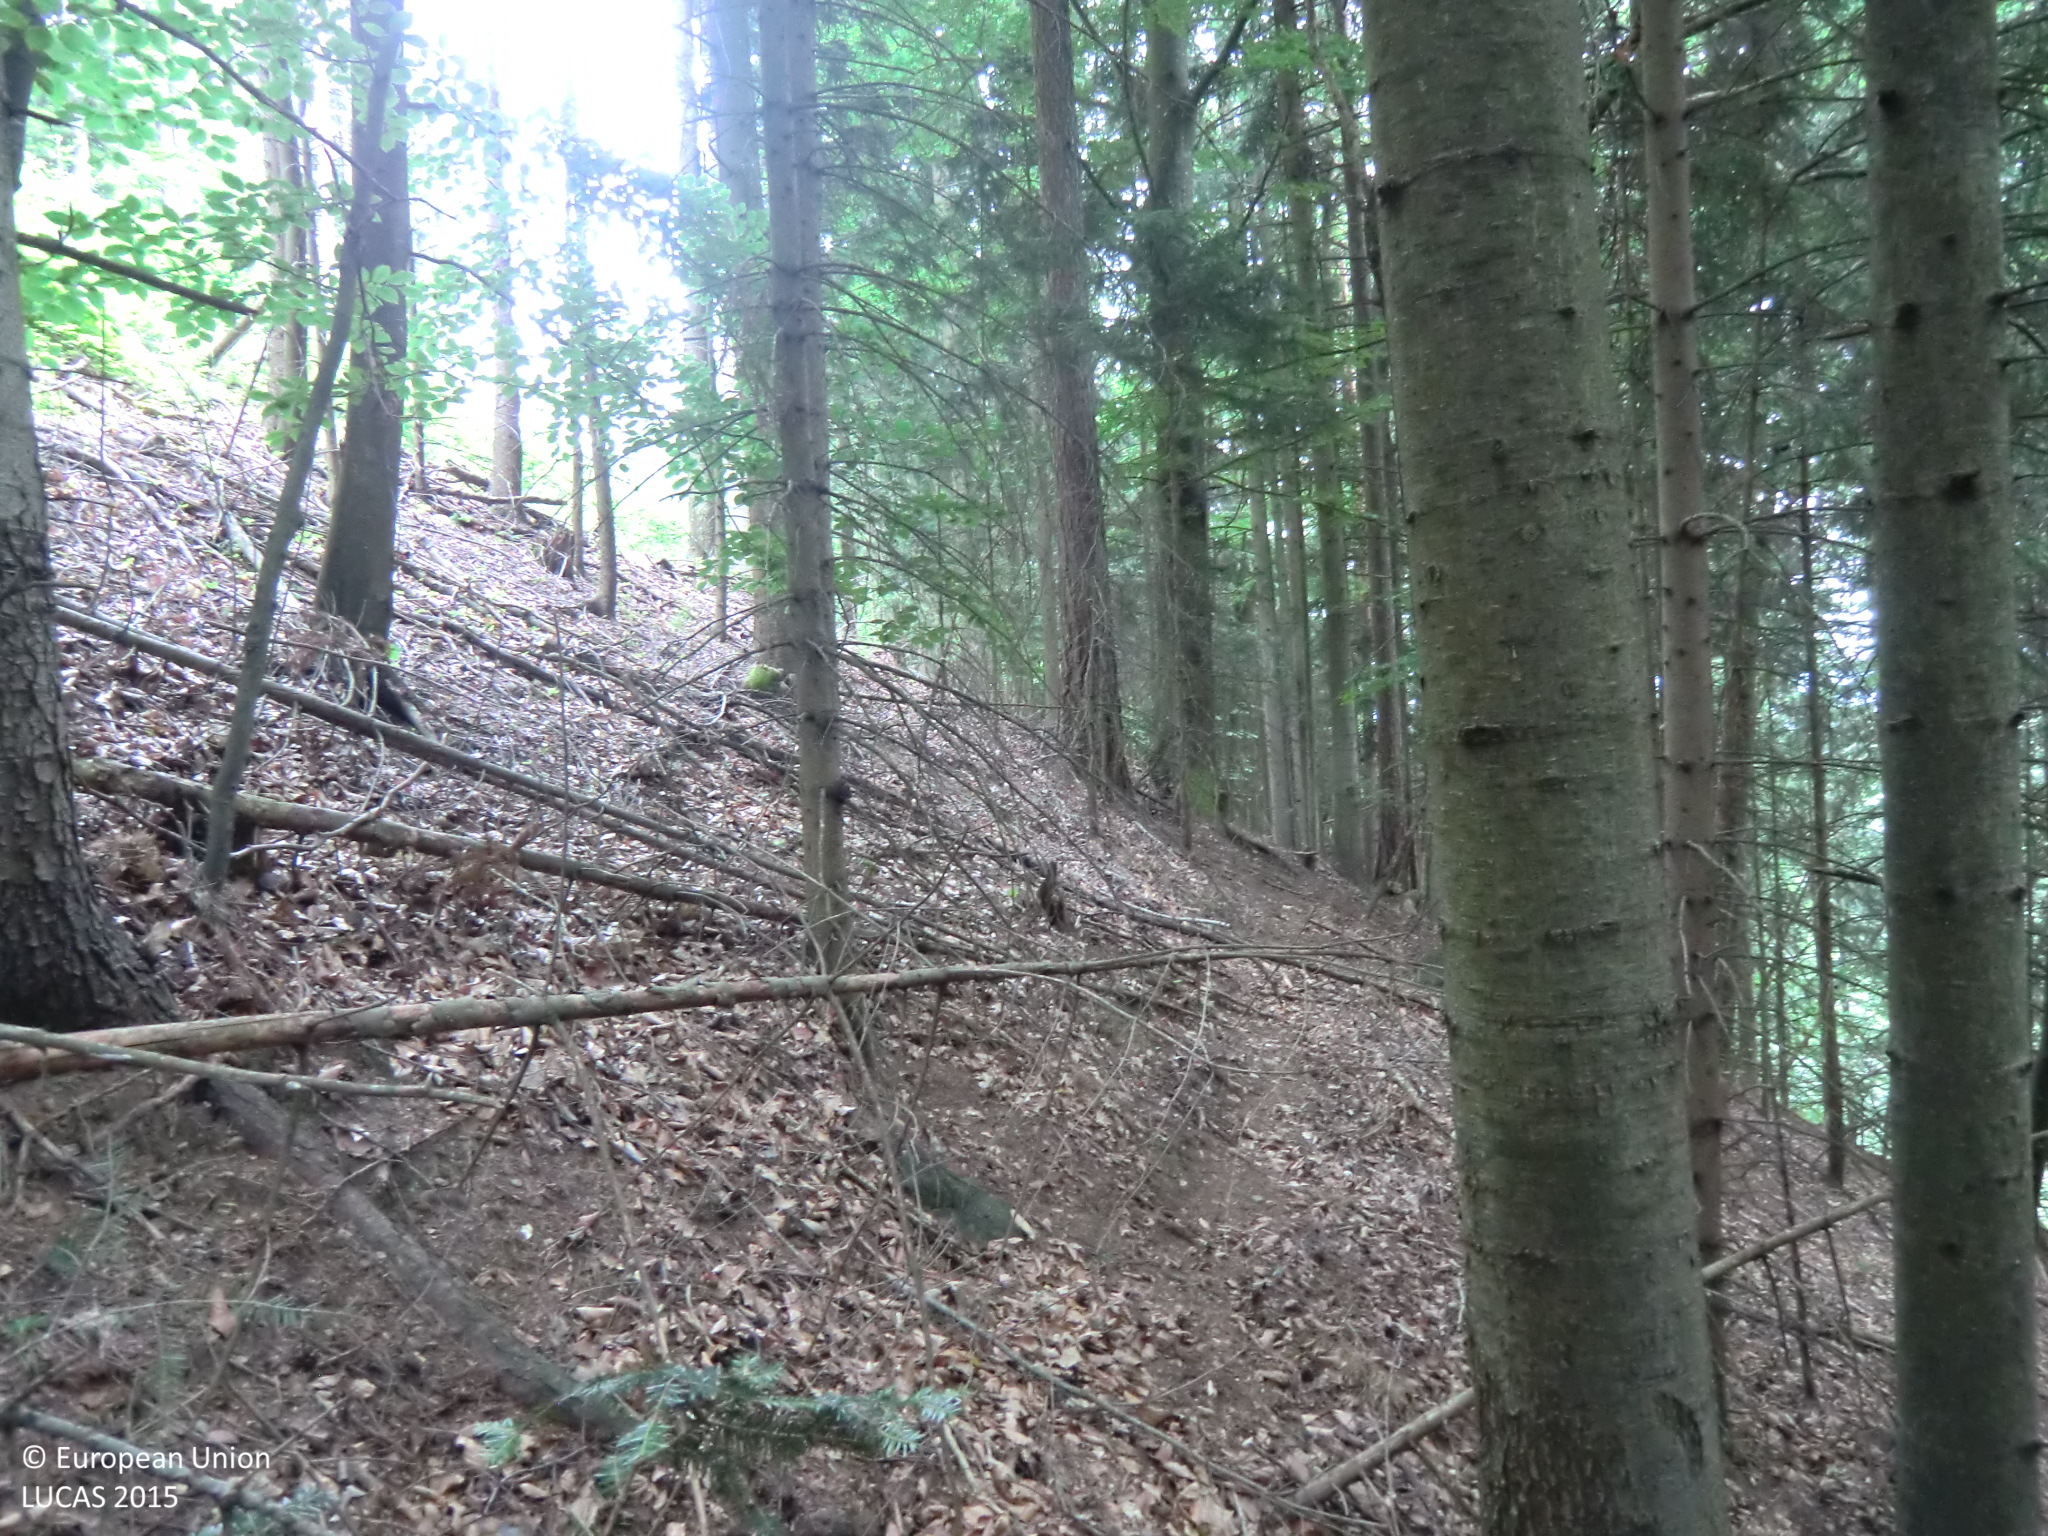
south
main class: Woodland
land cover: Spruce dominated mixed woodland
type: hemiboreal forest and nemoral coniferous forest and mixed broadleaved-coniferous forest
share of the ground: > 75 %
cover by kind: coniferous forest trees 45 %, broadleaved forest trees 45 %, unconsolidated bare surface 10 %
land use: Forestry
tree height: > 5 m
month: June
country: AT
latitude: 47.2616
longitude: 15.7498
